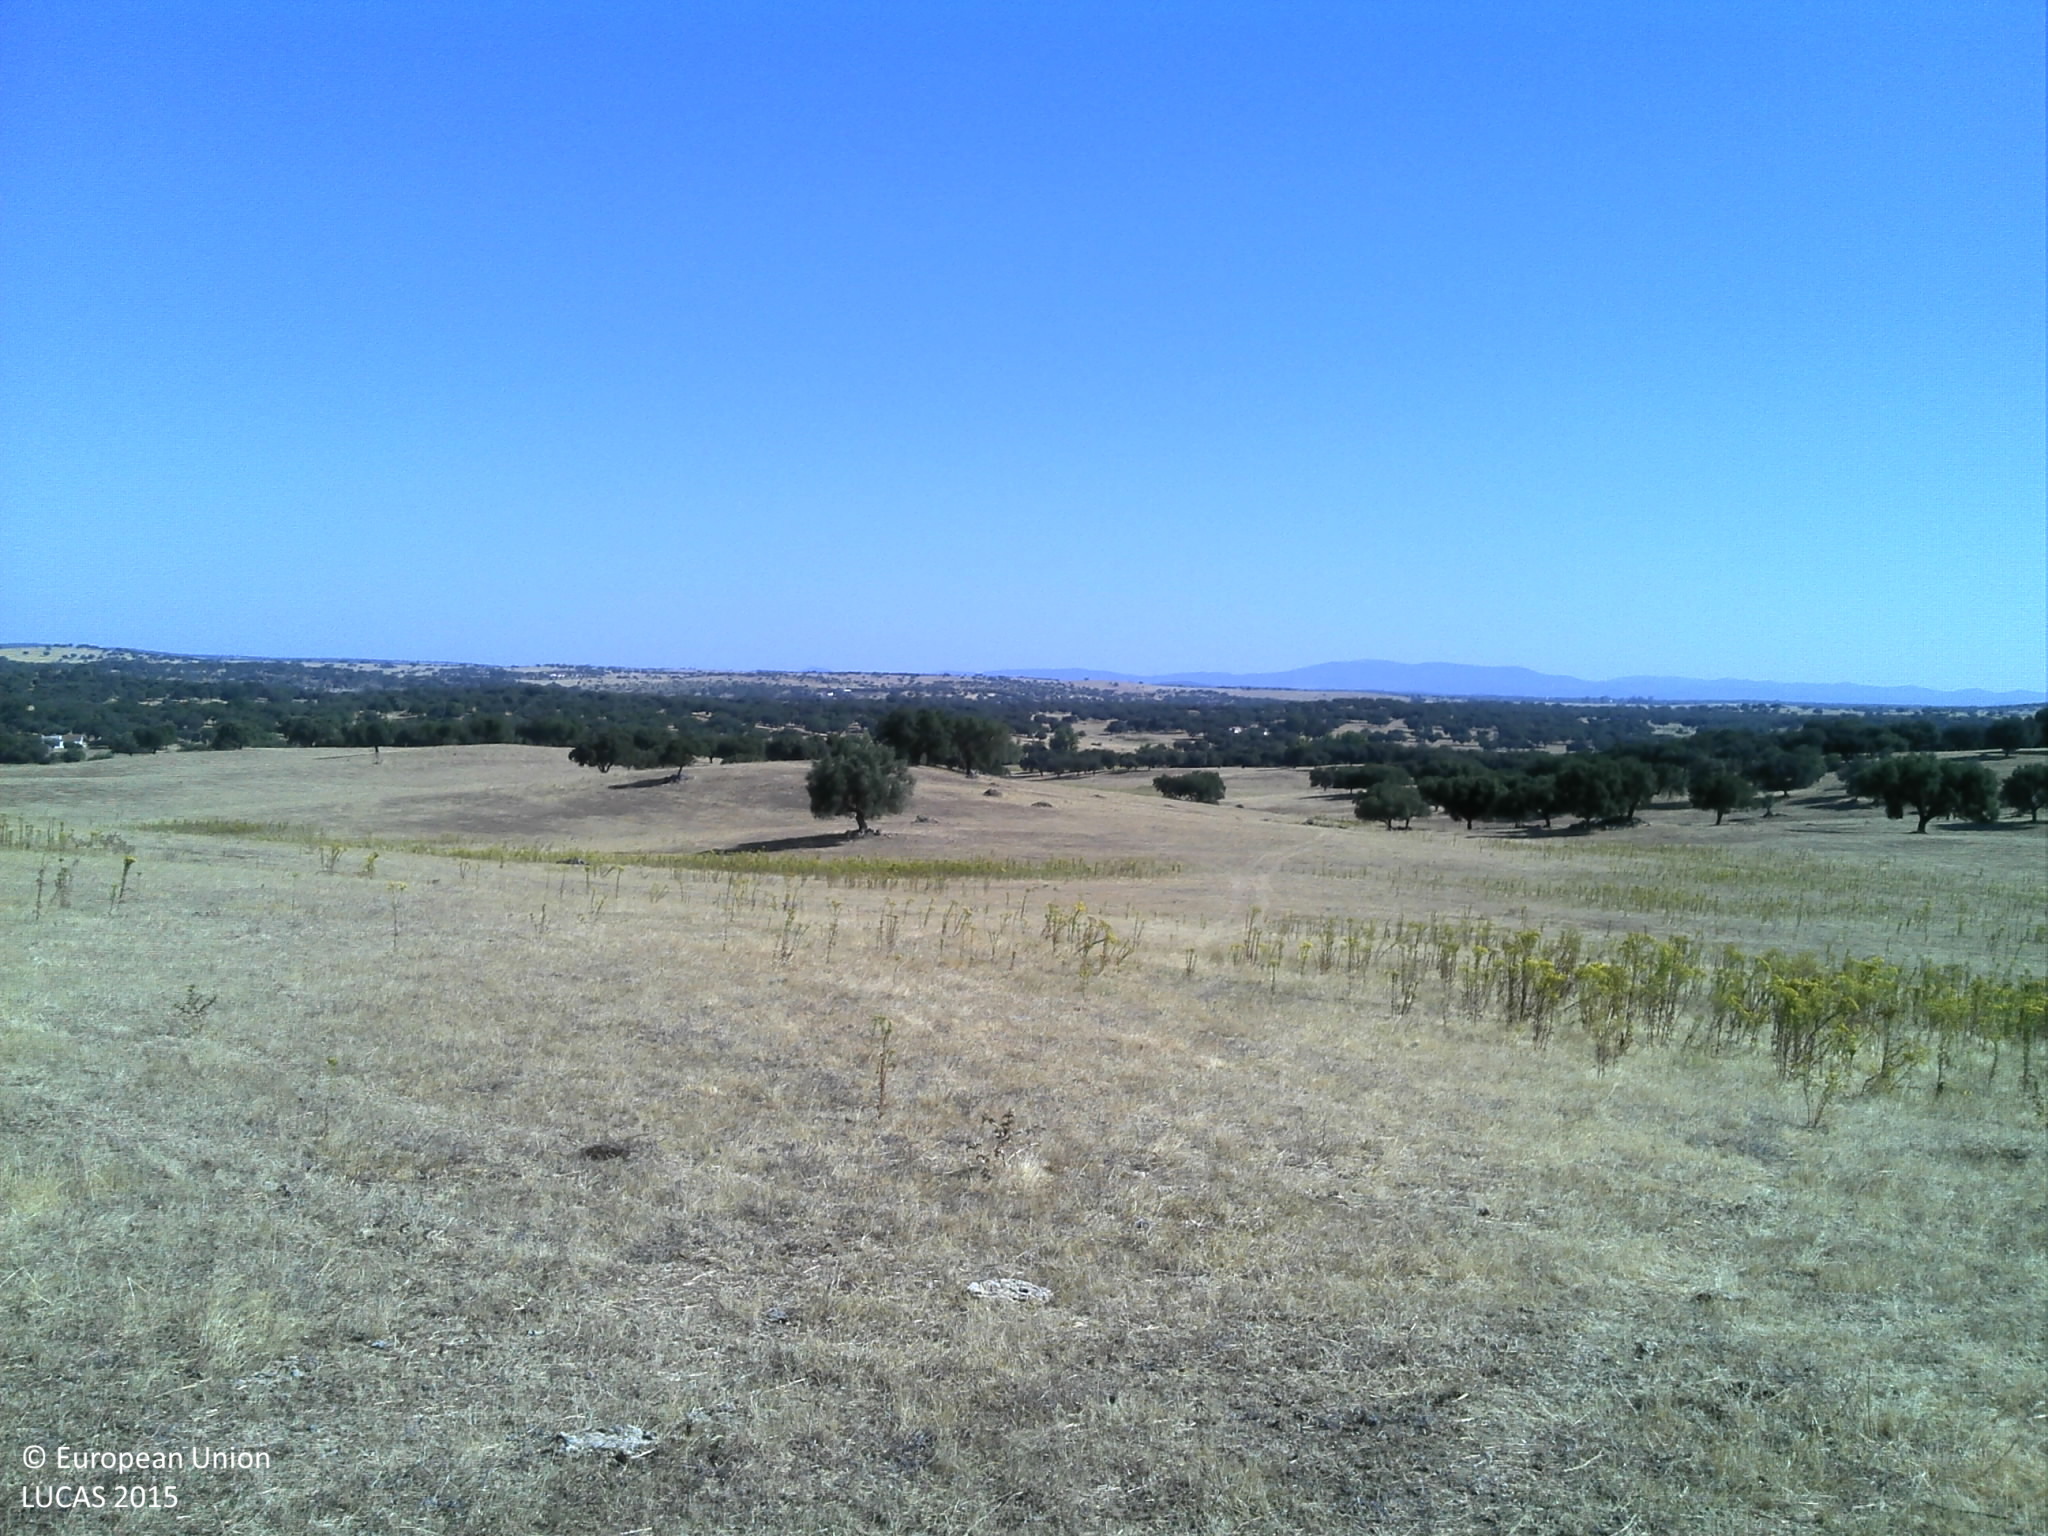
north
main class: Grassland
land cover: Grassland without tree/shrub cover
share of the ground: 25 - 50 %
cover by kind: unconsolidated bare surface 70 %, herbaceous plants 30 %
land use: Agriculture (excluding fallow land and kitchen gardens)
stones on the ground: < 10 %
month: July
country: PT
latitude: 39.0667
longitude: -7.4079
